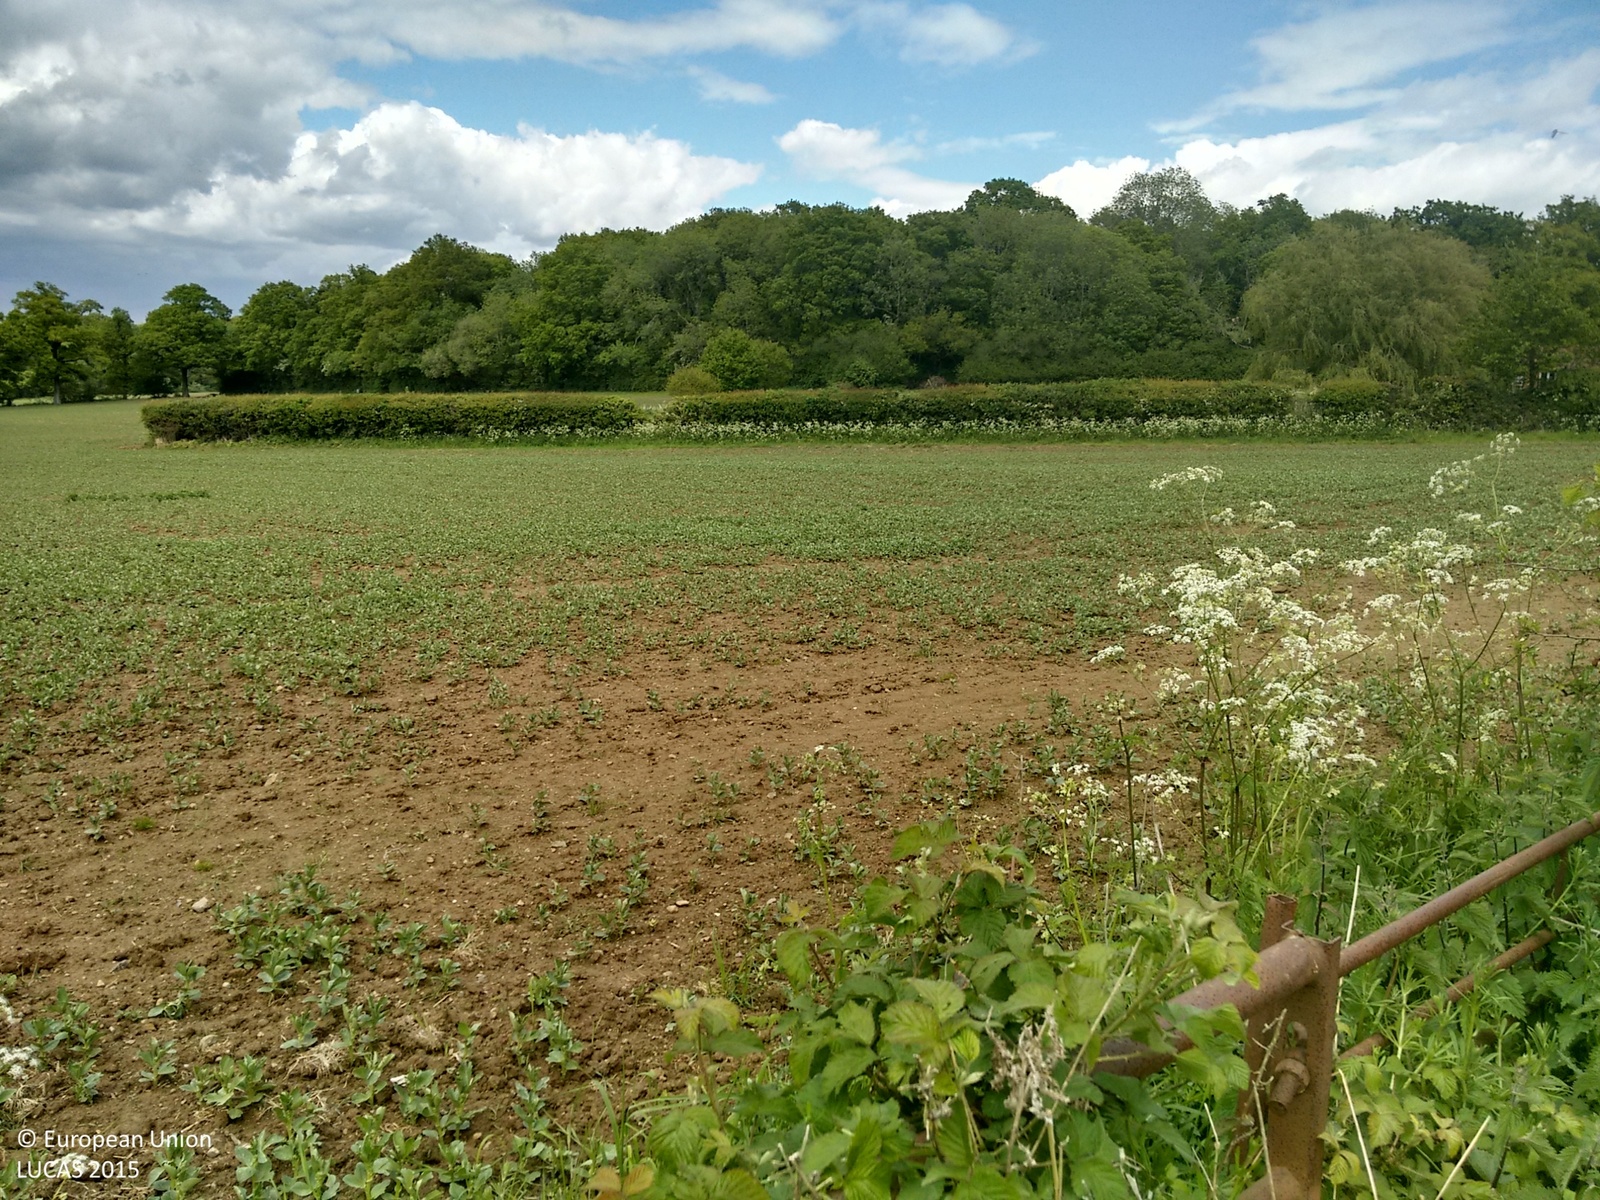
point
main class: Cropland
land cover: Dry pulses
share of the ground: 50 - 75 %
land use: Agriculture (excluding fallow land and kitchen gardens)
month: May
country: GB
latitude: 51.1514
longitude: 0.1470
